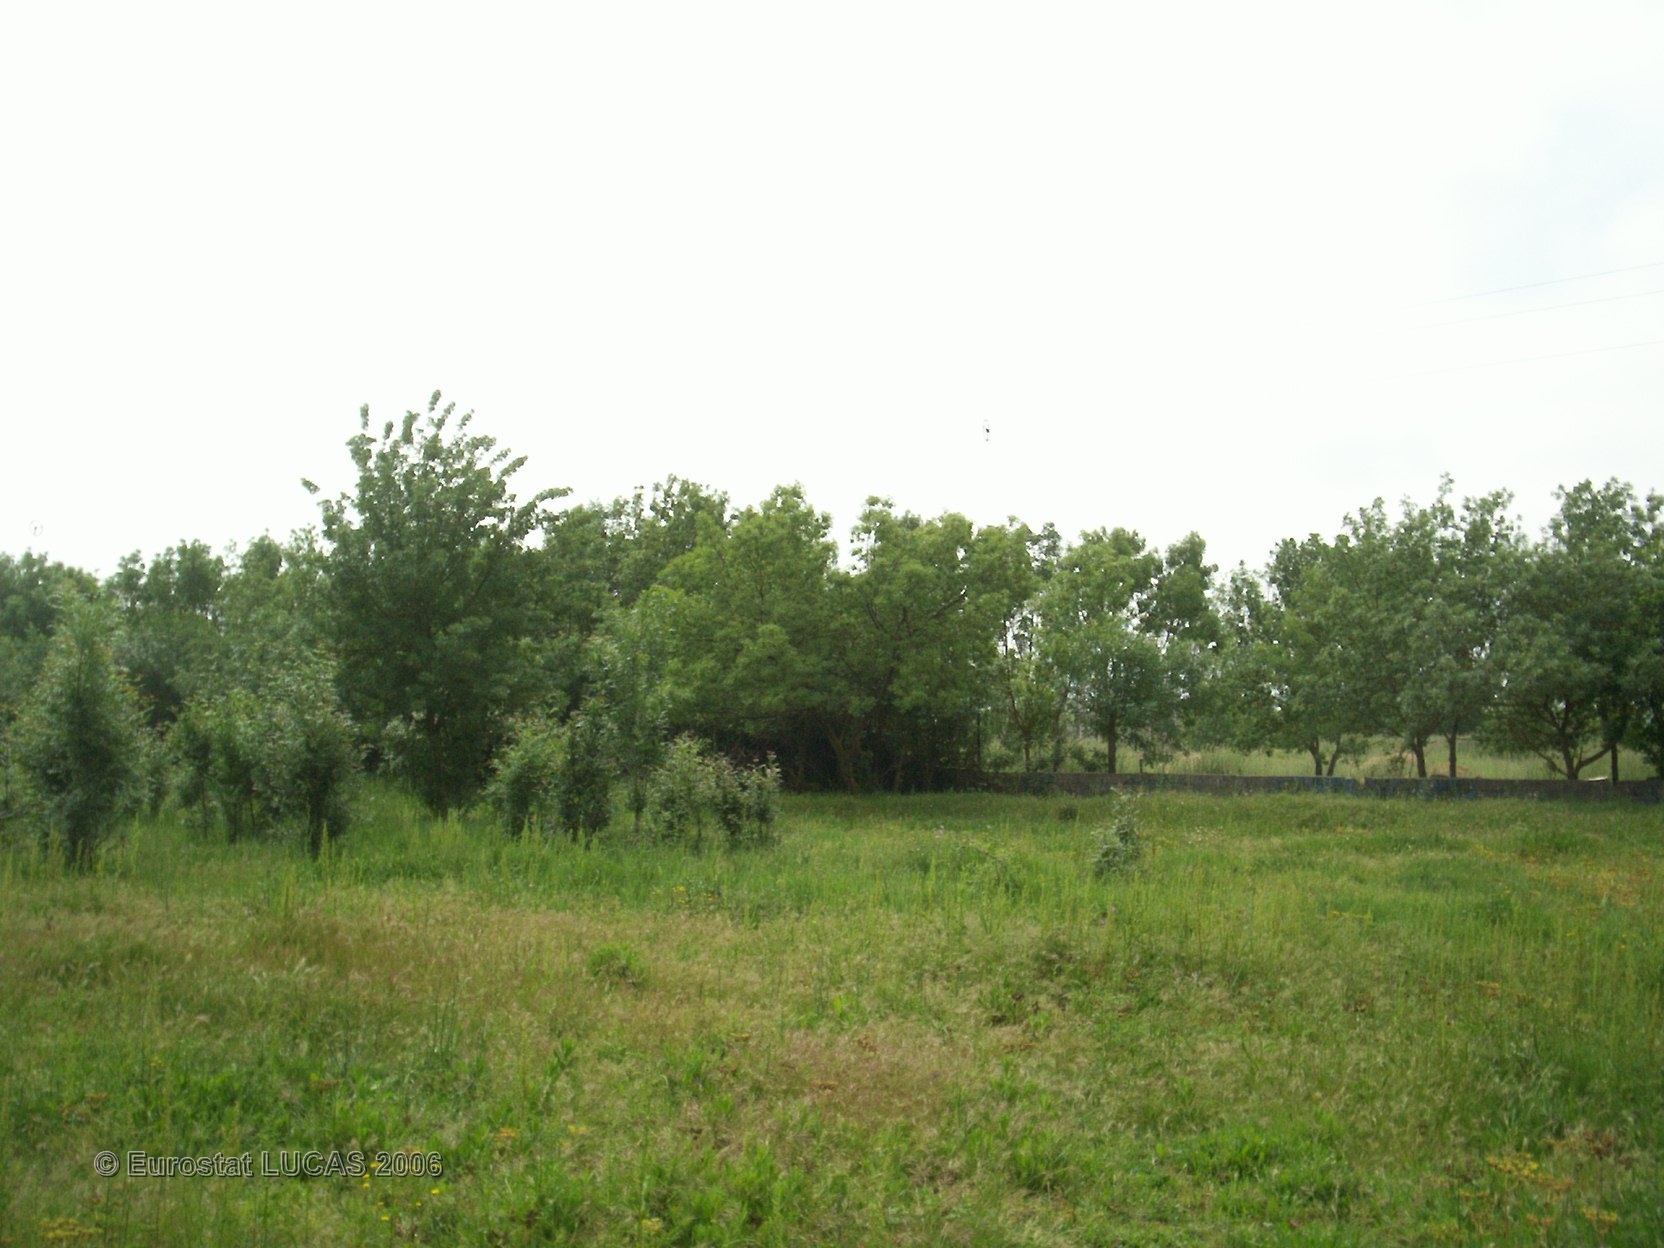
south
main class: Grassland
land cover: Grassland with sparse tree/shrub cover
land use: Agriculture (excluding fallow land and kitchen gardens)
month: May
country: FR
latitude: 43.3119
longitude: 3.4631
